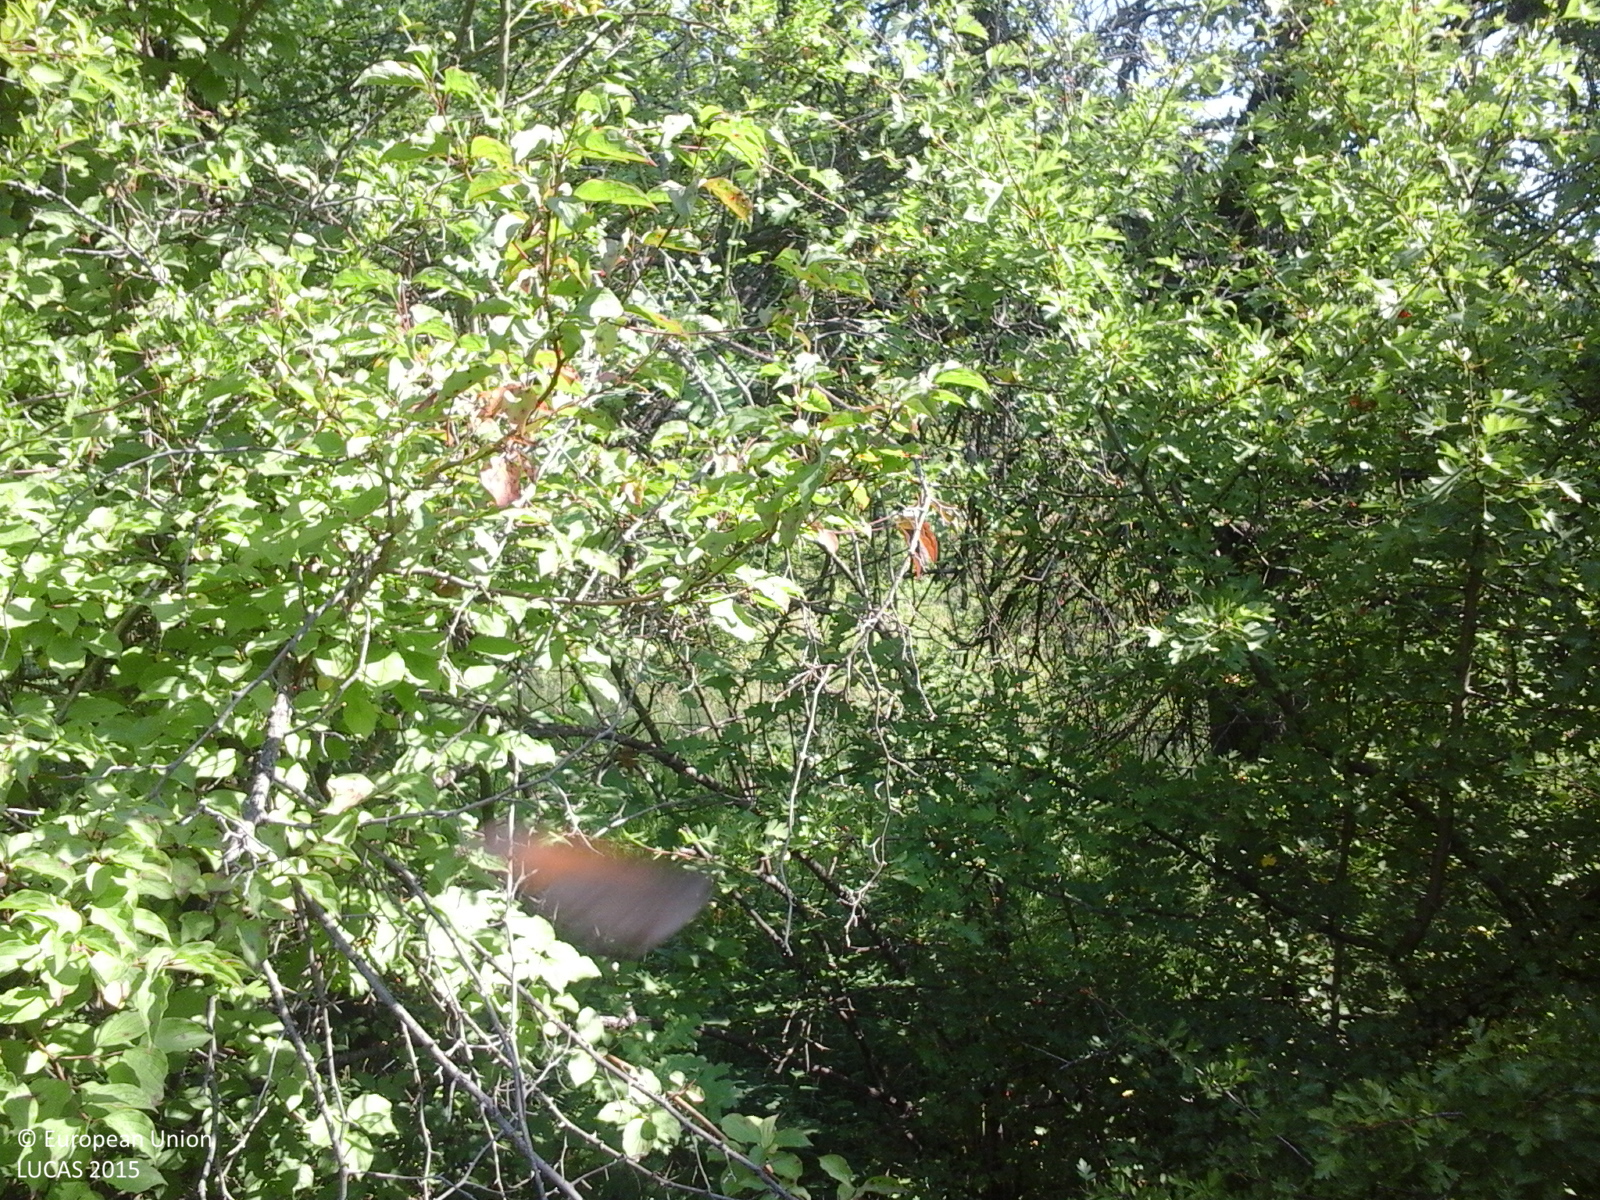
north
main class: Woodland
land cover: Broadleaved woodland
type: acidophilous oak and oak-birch forest
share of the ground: > 75 %
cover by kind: broadleaved forest trees 100 %
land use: Forestry
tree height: > 5 m
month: July
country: RO
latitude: 44.7975
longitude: 24.5748
